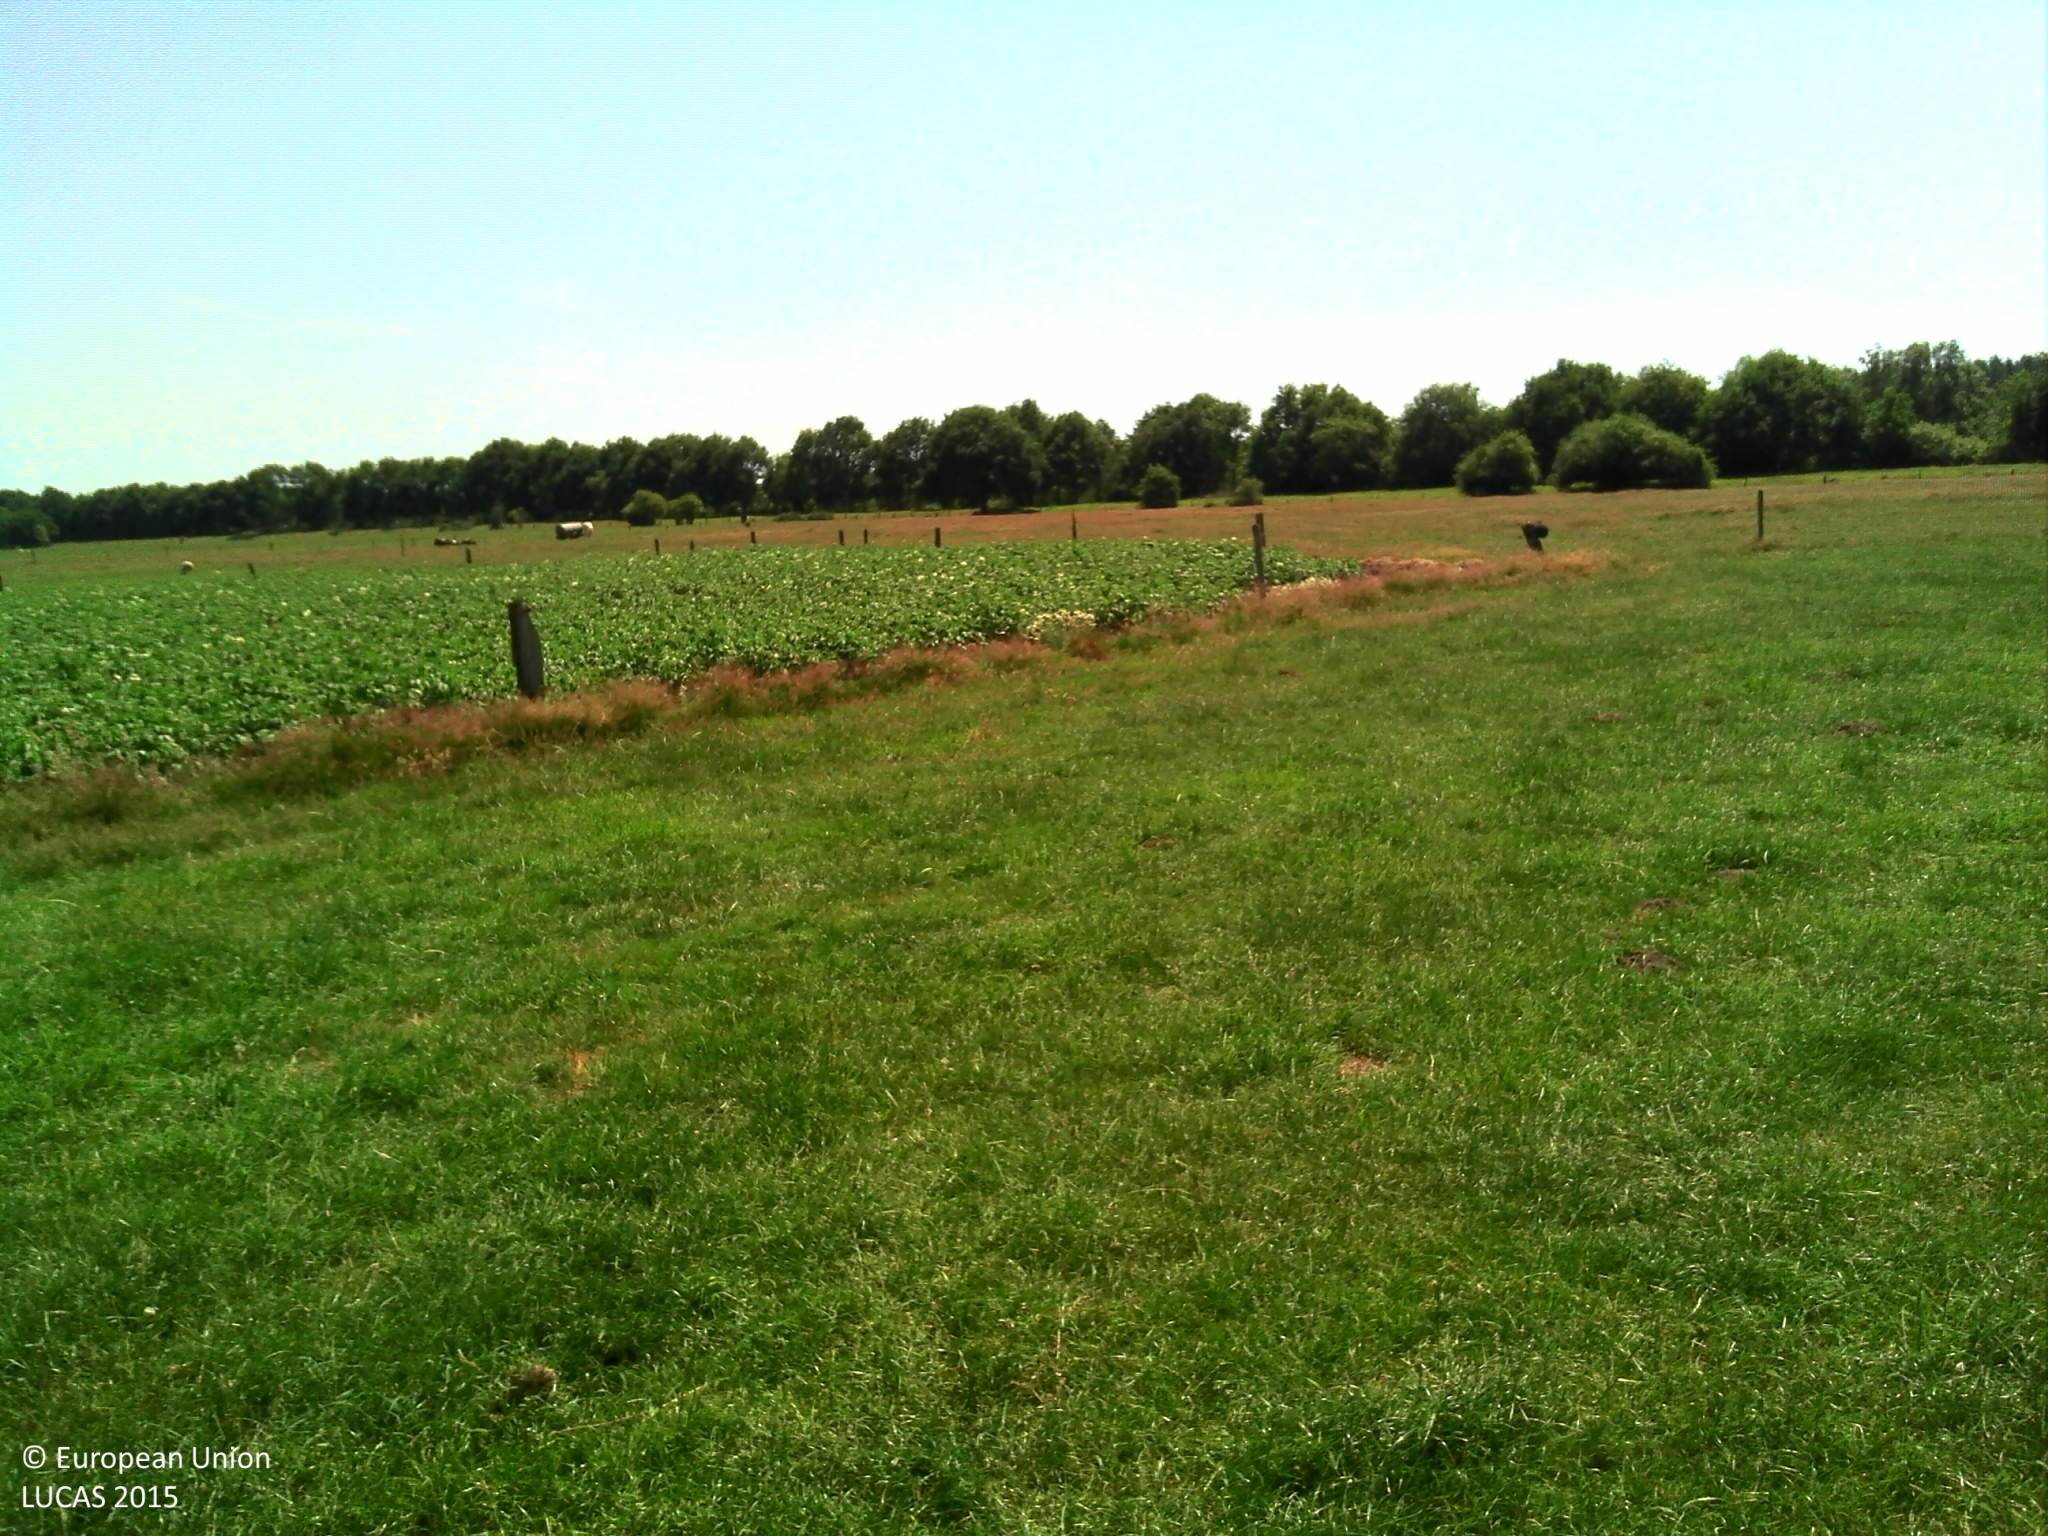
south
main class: Grassland
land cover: Grassland without tree/shrub cover
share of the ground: > 75 %
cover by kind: herbaceous plants 100 %
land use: Agriculture (excluding fallow land and kitchen gardens)
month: July
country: BE
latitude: 51.1119
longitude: 3.4068
